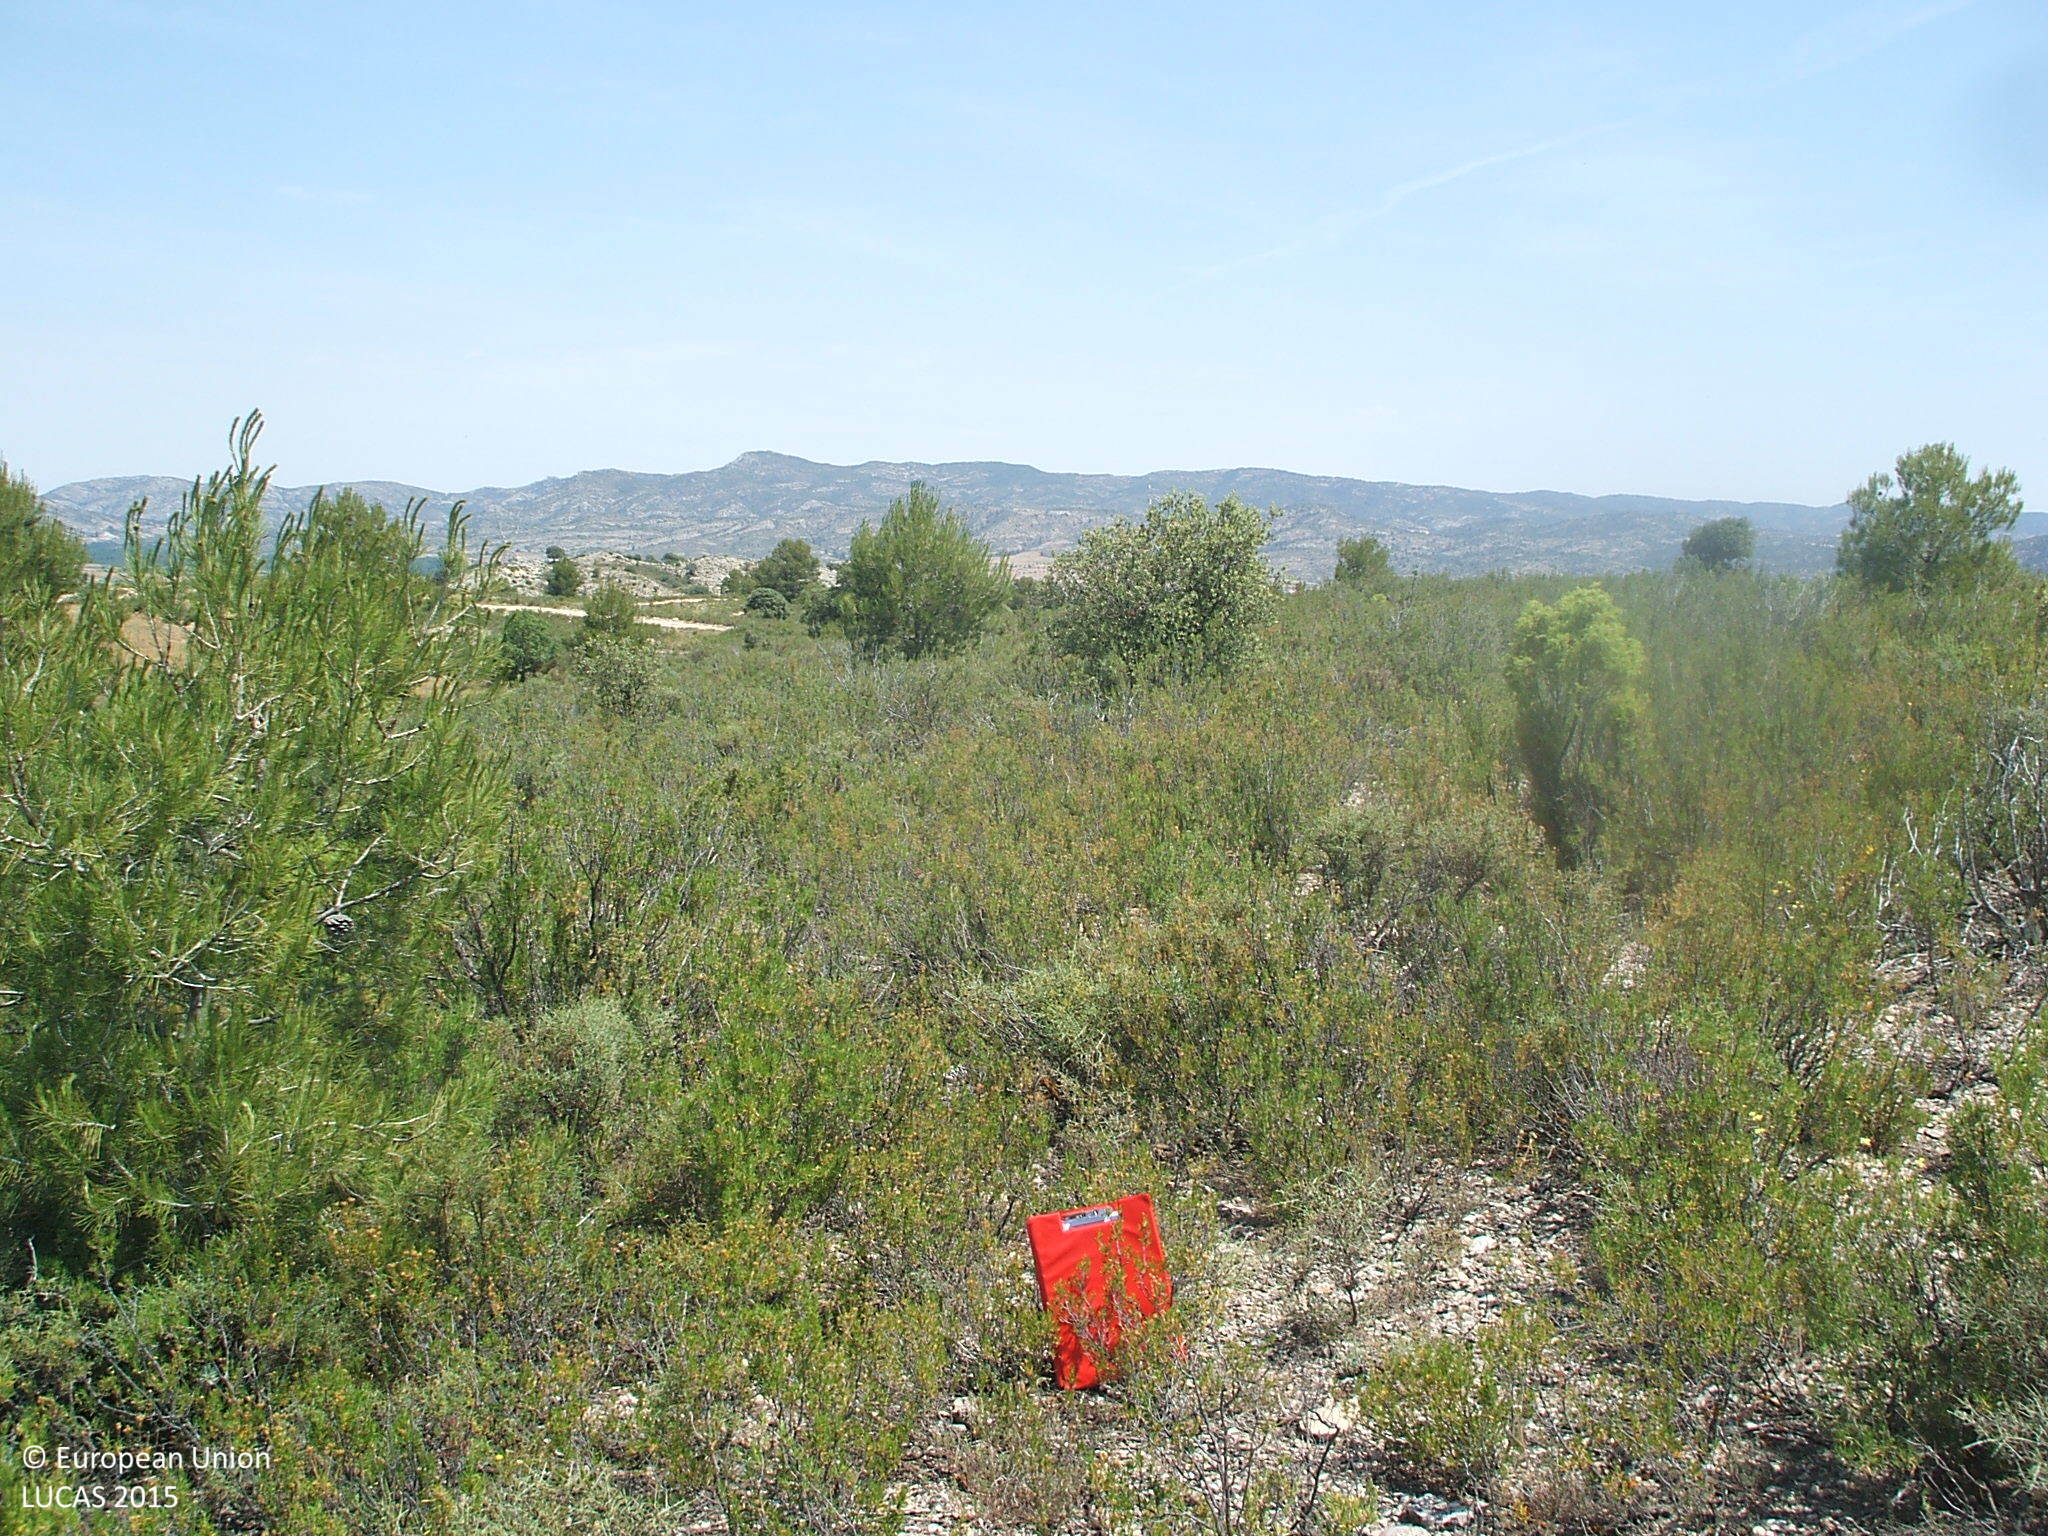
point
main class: Shrubland
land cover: Shrubland with sparse tree cover
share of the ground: > 75 %
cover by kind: shrubs 80 %, consolidated bare surface 15 %, coniferous forest trees 5 %
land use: Semi-natural and natural areas not in use
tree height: > 5 m
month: June
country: ES
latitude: 40.8254
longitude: -0.2189
